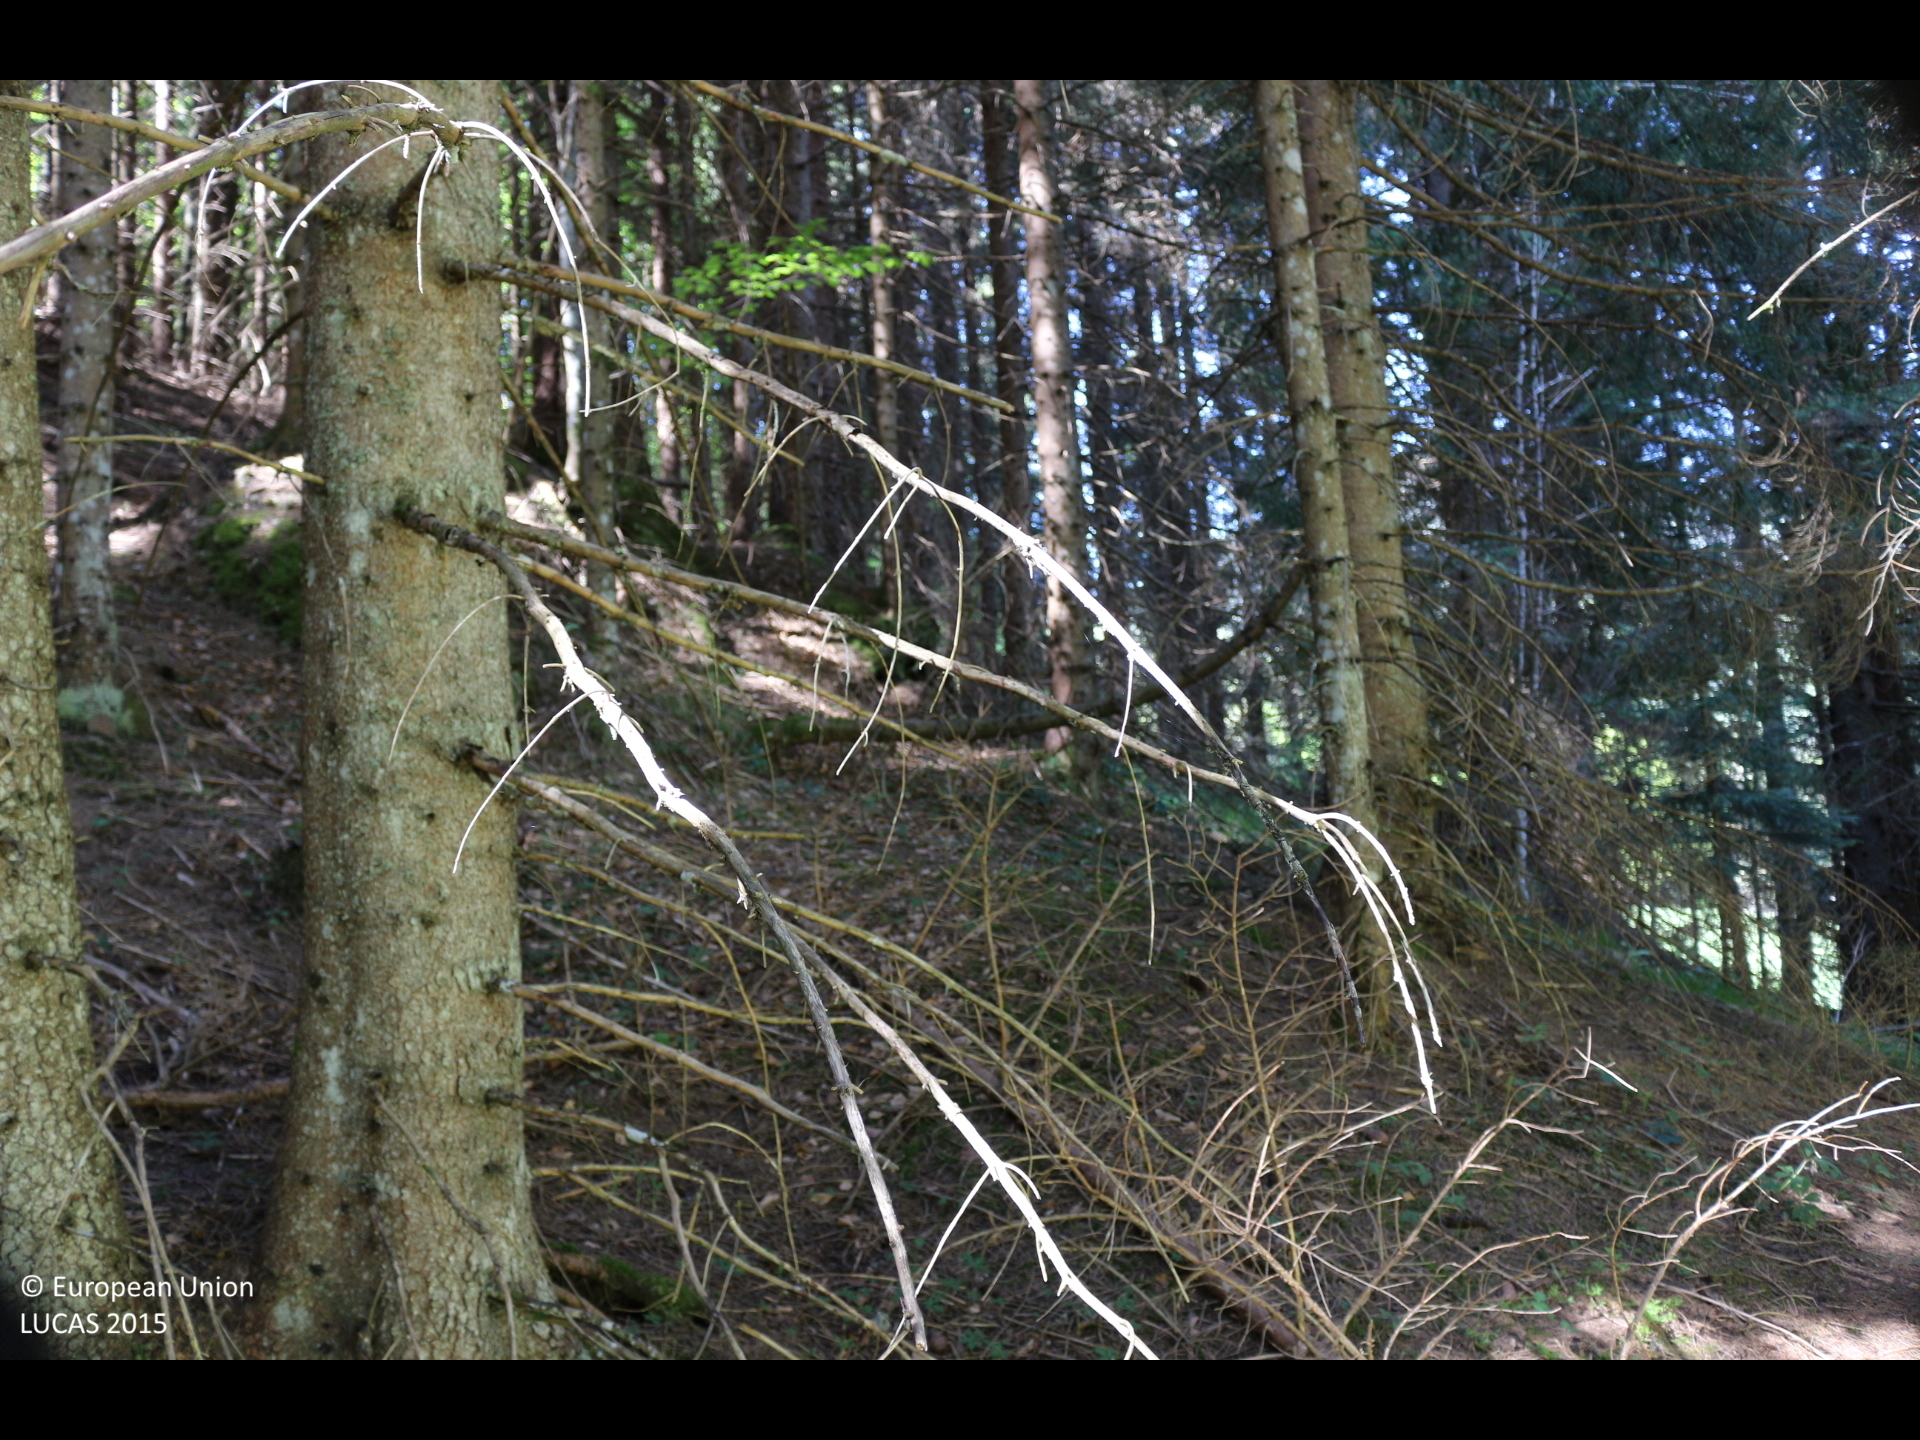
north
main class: Woodland
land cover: Spruce dominated coniferous woodland
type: alpine coniferous forest
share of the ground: > 75 %
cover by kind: coniferous forest trees 95 %, broadleaved forest trees 5 %
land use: Forestry
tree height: > 5 m
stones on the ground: < 10 %
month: May
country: AT
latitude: 46.4850
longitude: 14.2048
